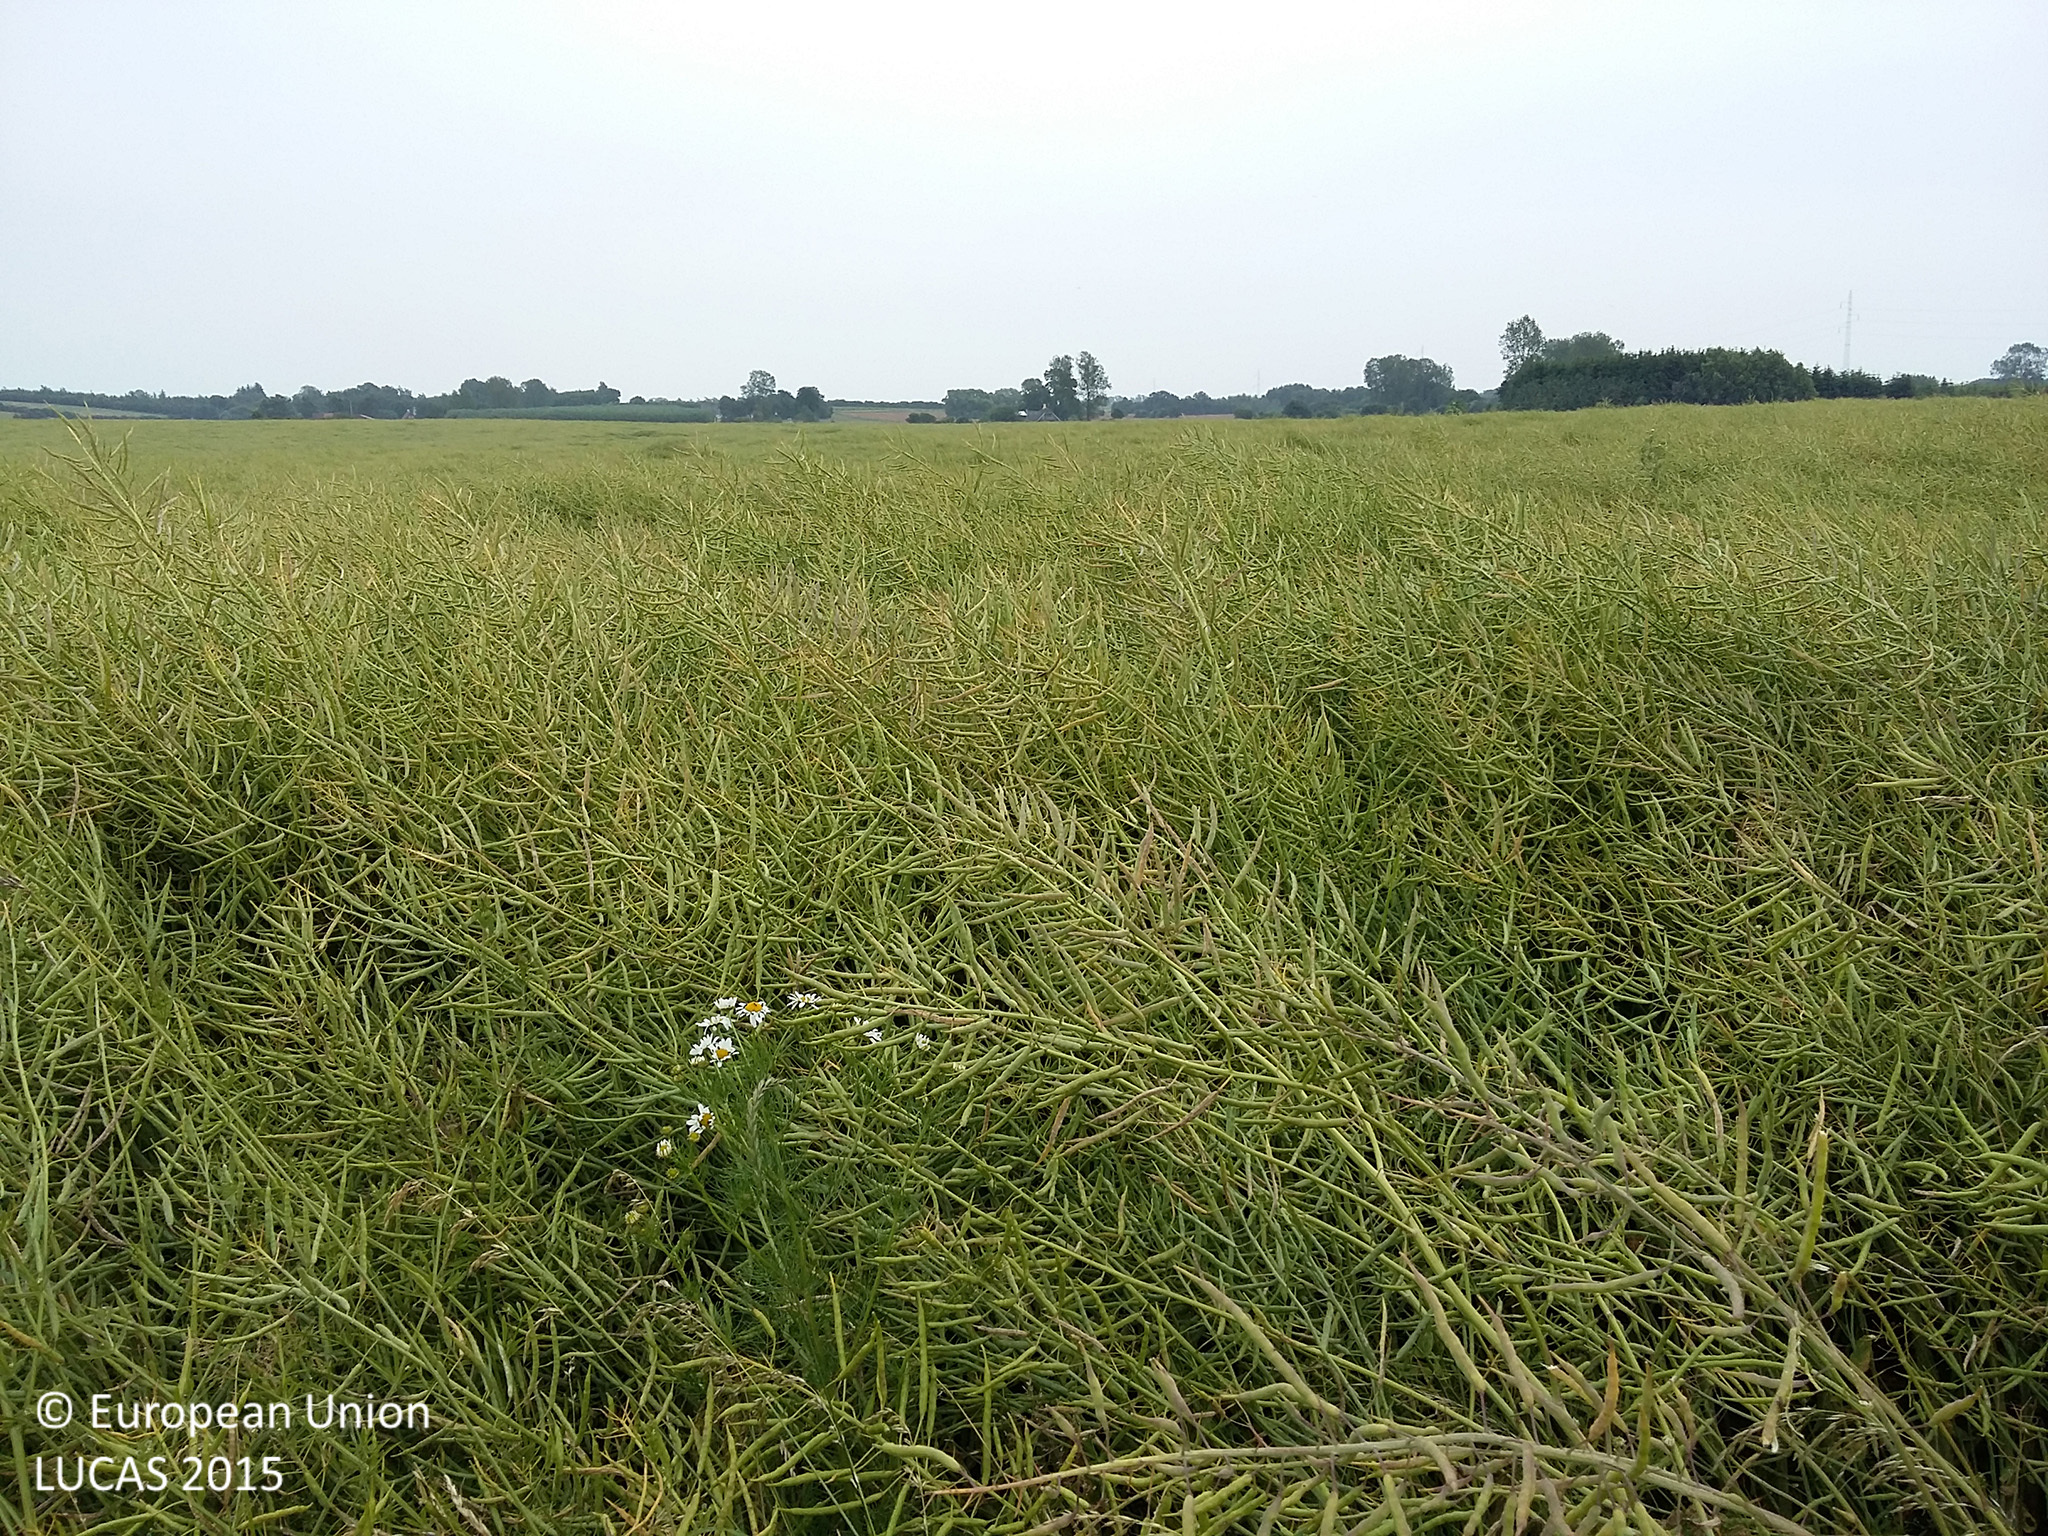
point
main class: Cropland
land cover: Rape and turnip rape
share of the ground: > 75 %
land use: Agriculture (excluding fallow land and kitchen gardens)
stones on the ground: < 10 %
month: July
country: DK
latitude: 55.2782
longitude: 11.6516
